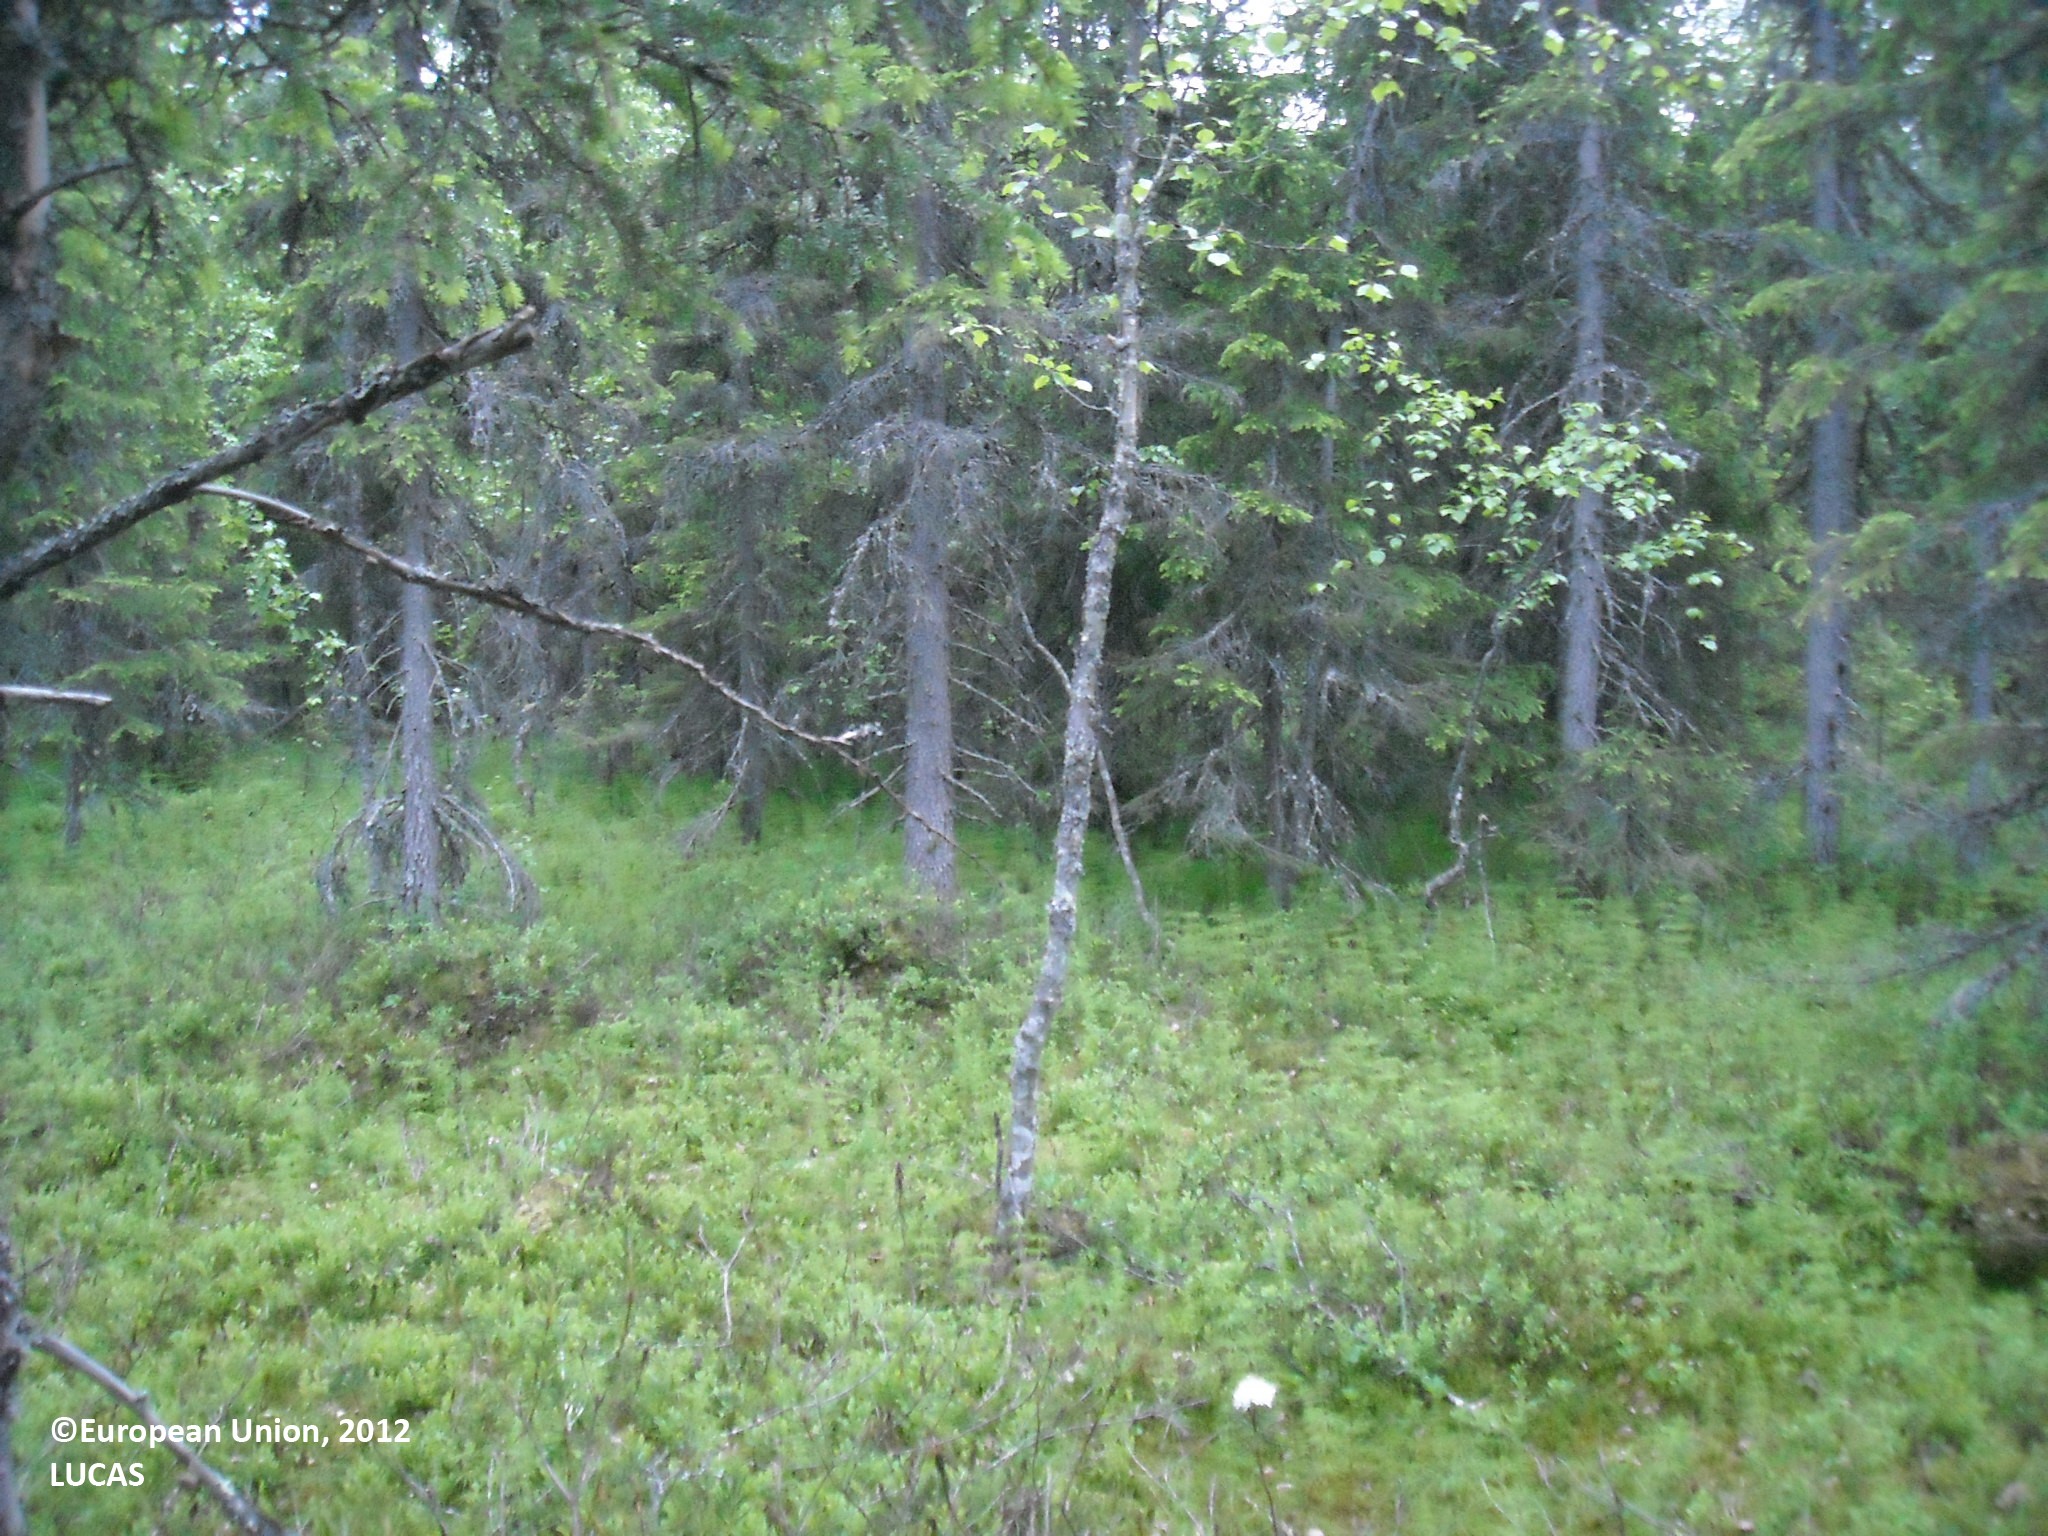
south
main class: Woodland
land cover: Other mixed woodland
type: boreal forest
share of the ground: > 75 %
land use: Forestry
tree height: > 5 m
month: June
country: FI
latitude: 64.9236
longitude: 27.9788
